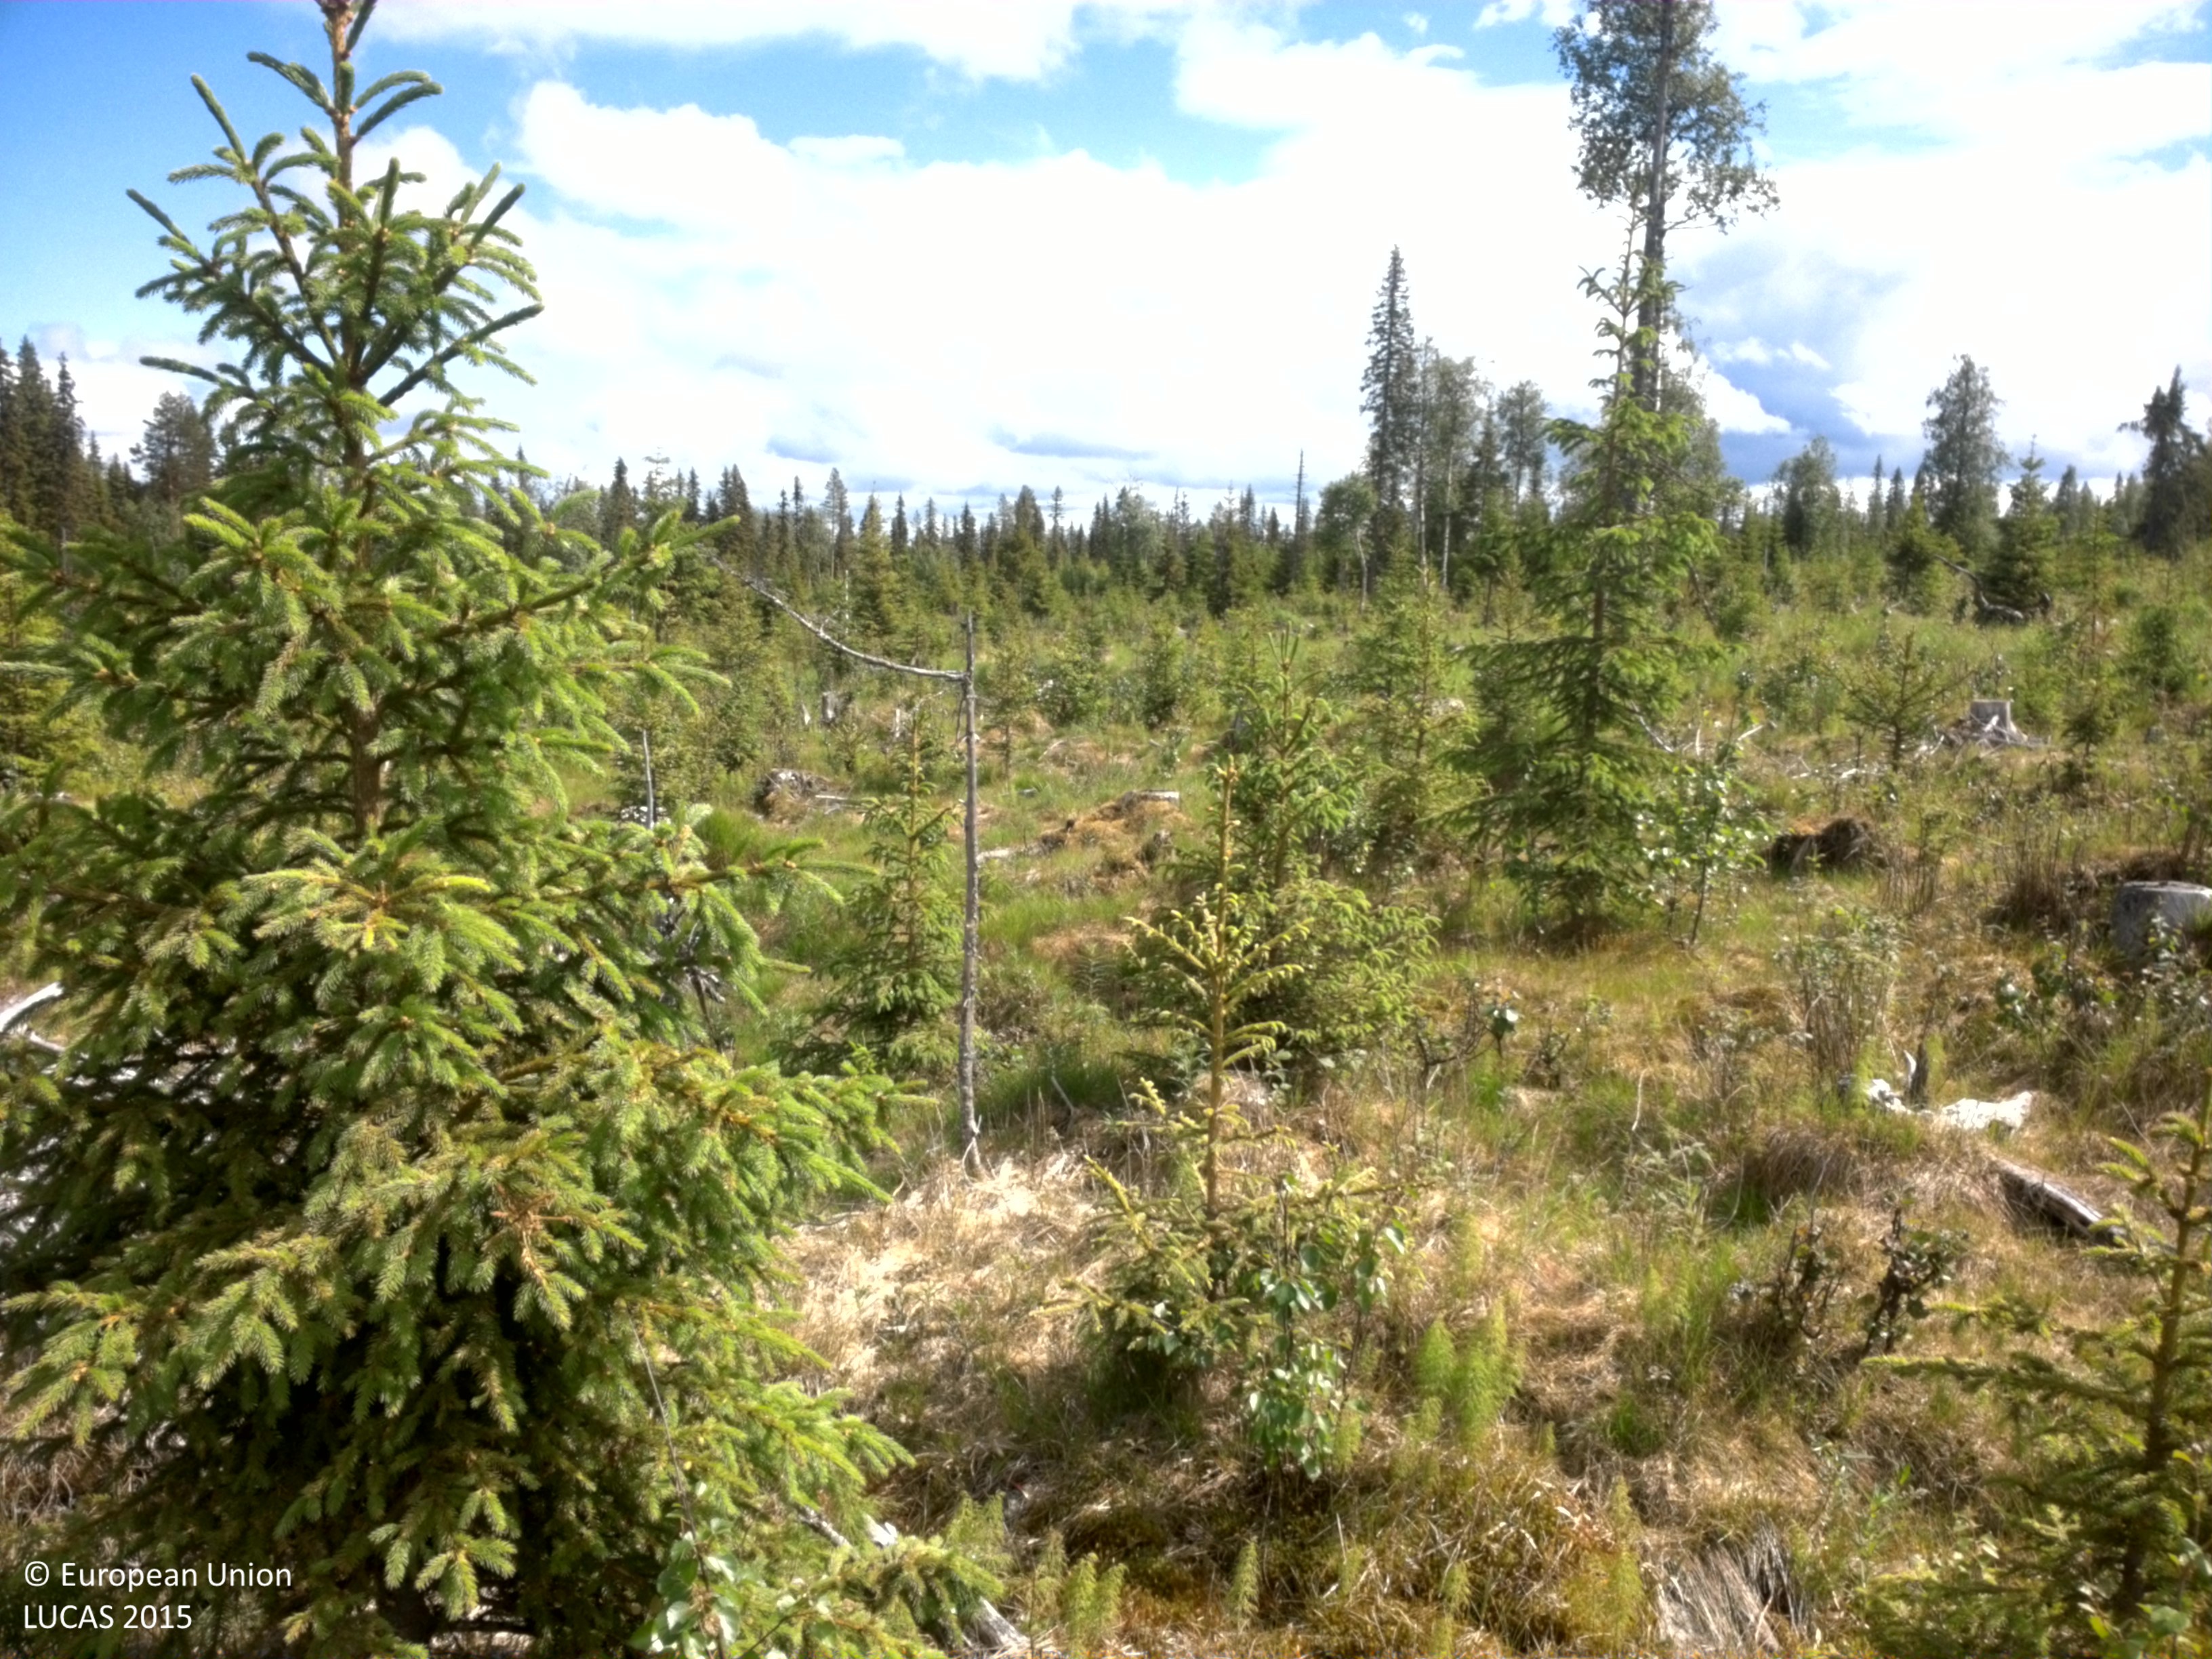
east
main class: Woodland
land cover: Spruce dominated mixed woodland
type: boreal forest
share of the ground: 50 - 75 %
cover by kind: coniferous forest trees 45 %, broadleaved forest trees 30 %, herbaceous plants 20 %, shrubs 5 %
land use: Forestry
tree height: < 5 m
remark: Clear cut
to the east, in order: Spruce dominated mixed woodland; Ditches and canals; Spruce dominated mixed woodland; Ditches and canals; Spruce dominated mixed woodland; Paved roads, cycling and walking lanes; Ditches and canals; Spruce dominated mixed woodland; Spruce dominated coniferous woodland; Pine dominated coniferous woodland
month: July
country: SE
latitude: 64.4796
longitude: 18.1435
